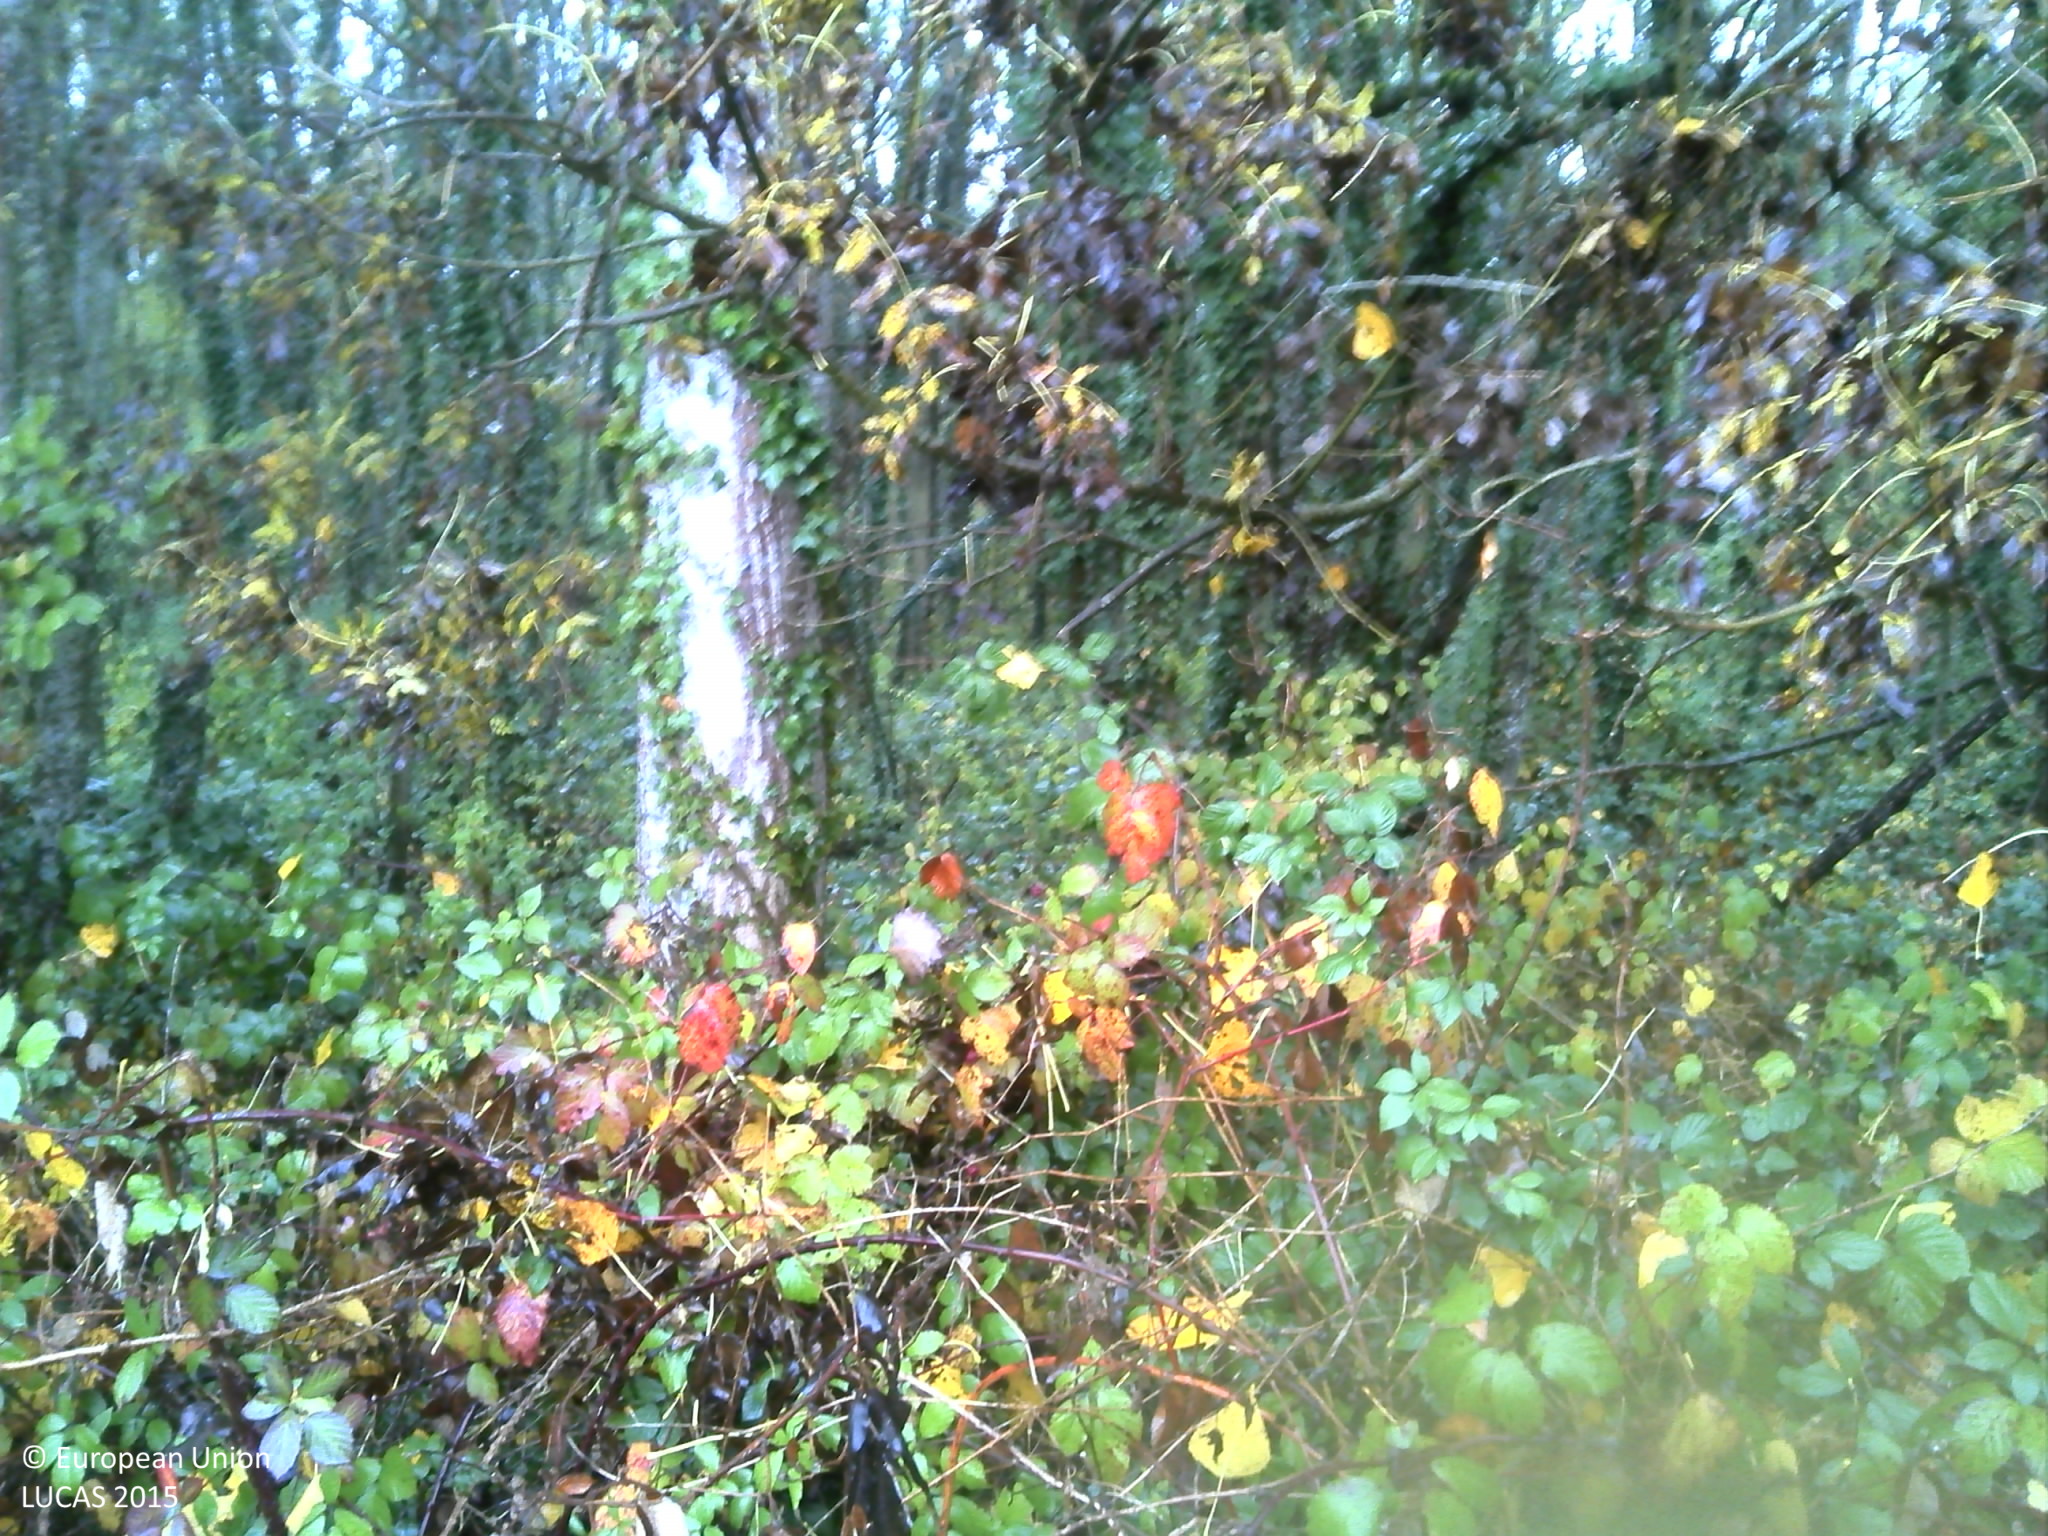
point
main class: Woodland
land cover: Broadleaved woodland
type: non-riverine alder, birch or aspen forest
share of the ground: > 75 %
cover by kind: broadleaved forest trees 100 %
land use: Forestry
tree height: > 5 m
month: October
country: FR
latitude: 47.0504
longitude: 5.0911
